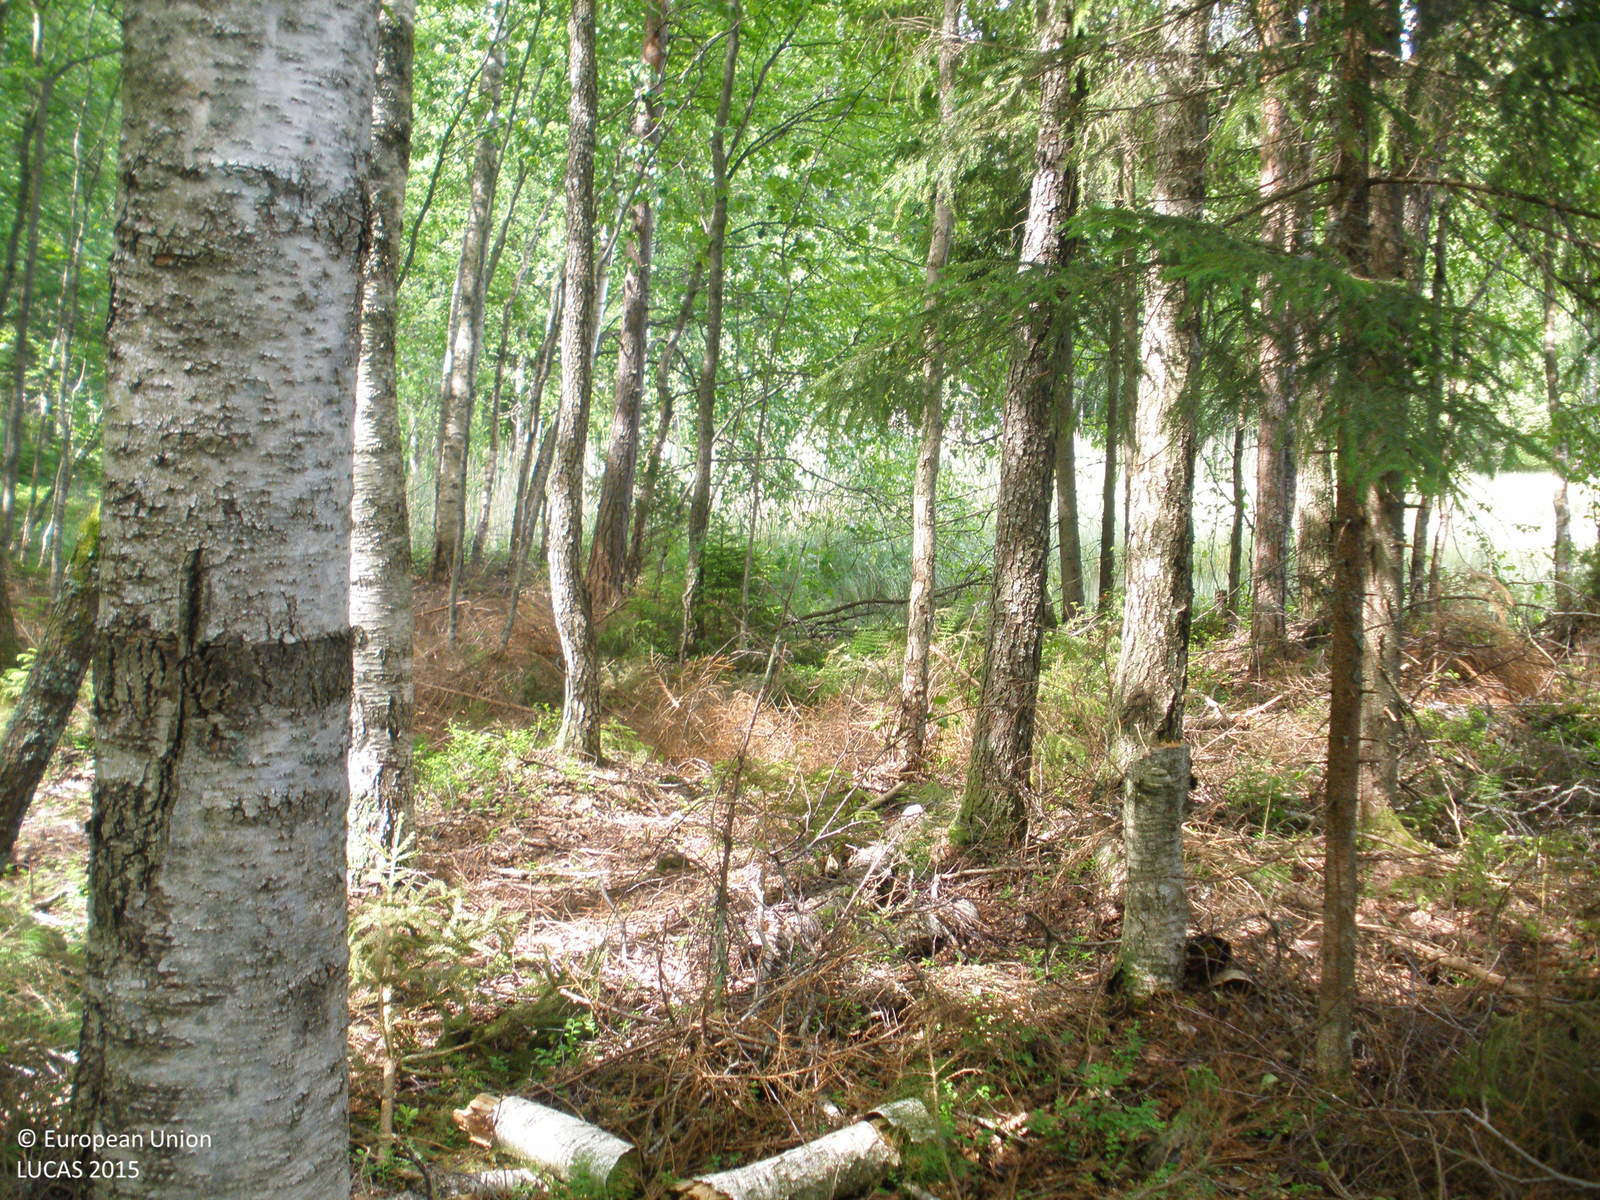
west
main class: Woodland
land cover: Spruce dominated mixed woodland
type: boreal forest
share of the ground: > 75 %
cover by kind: broadleaved forest trees 50 %, coniferous forest trees 35 %, herbaceous plants 10 %, shrubs 5 %
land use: Forestry
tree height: > 5 m
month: June
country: FI
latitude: 61.0011
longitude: 23.6023
